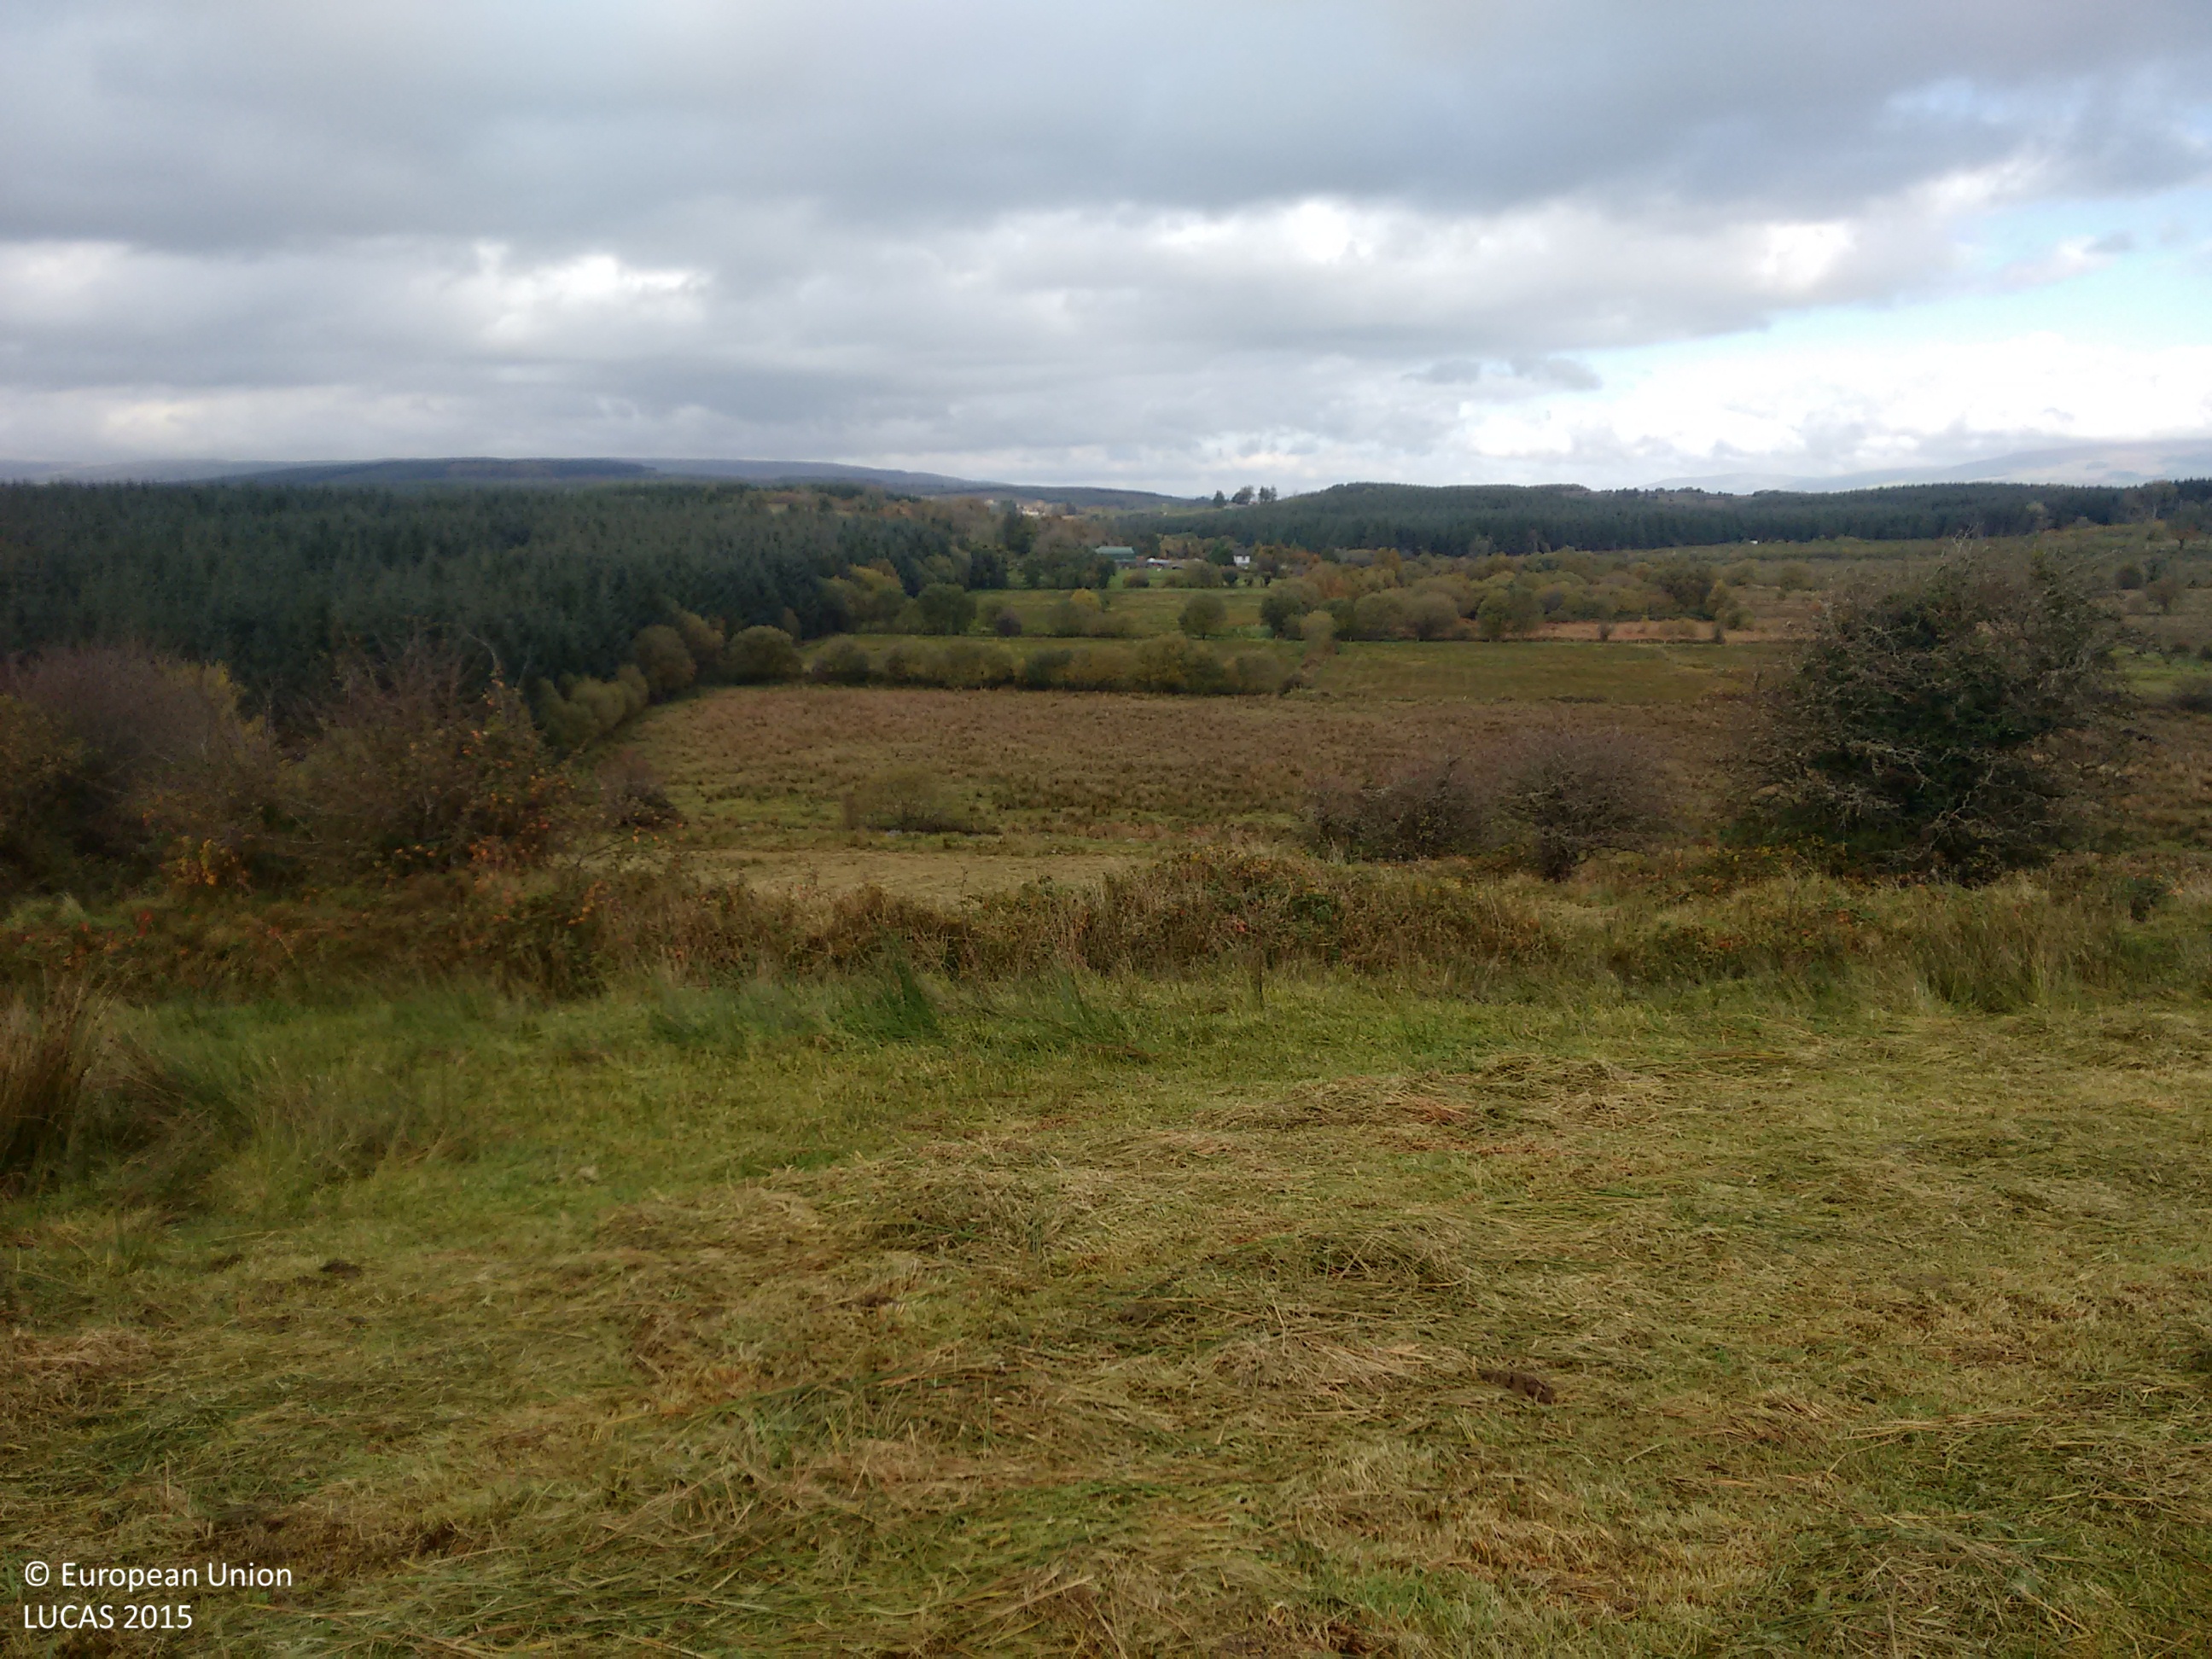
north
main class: Grassland
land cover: Grassland without tree/shrub cover
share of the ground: > 75 %
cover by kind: herbaceous plants 100 %
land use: Agriculture (excluding fallow land and kitchen gardens)
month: October
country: IE
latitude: 53.9917
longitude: -8.1312
